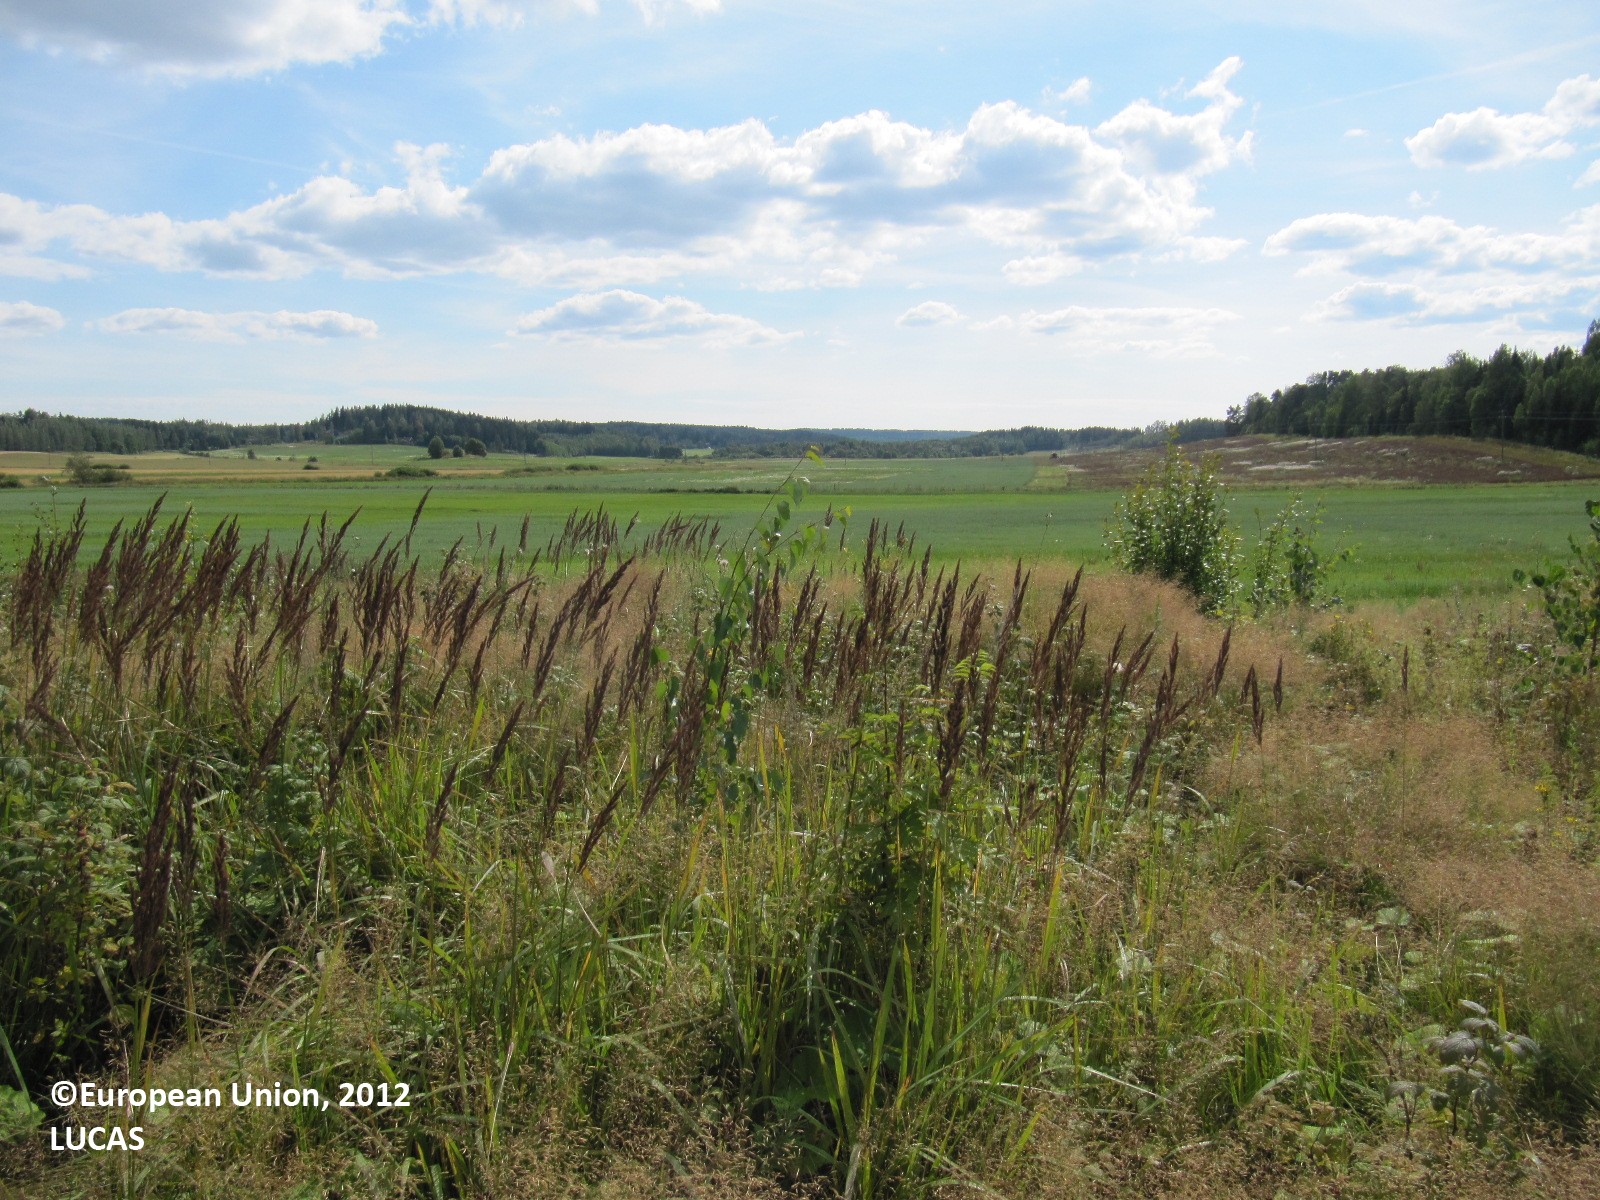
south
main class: Grassland
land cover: Grassland with sparse tree/shrub cover
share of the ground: > 75 %
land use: Semi-natural and natural areas not in use
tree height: < 5 m
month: August
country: FI
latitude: 60.3815
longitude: 24.3063
